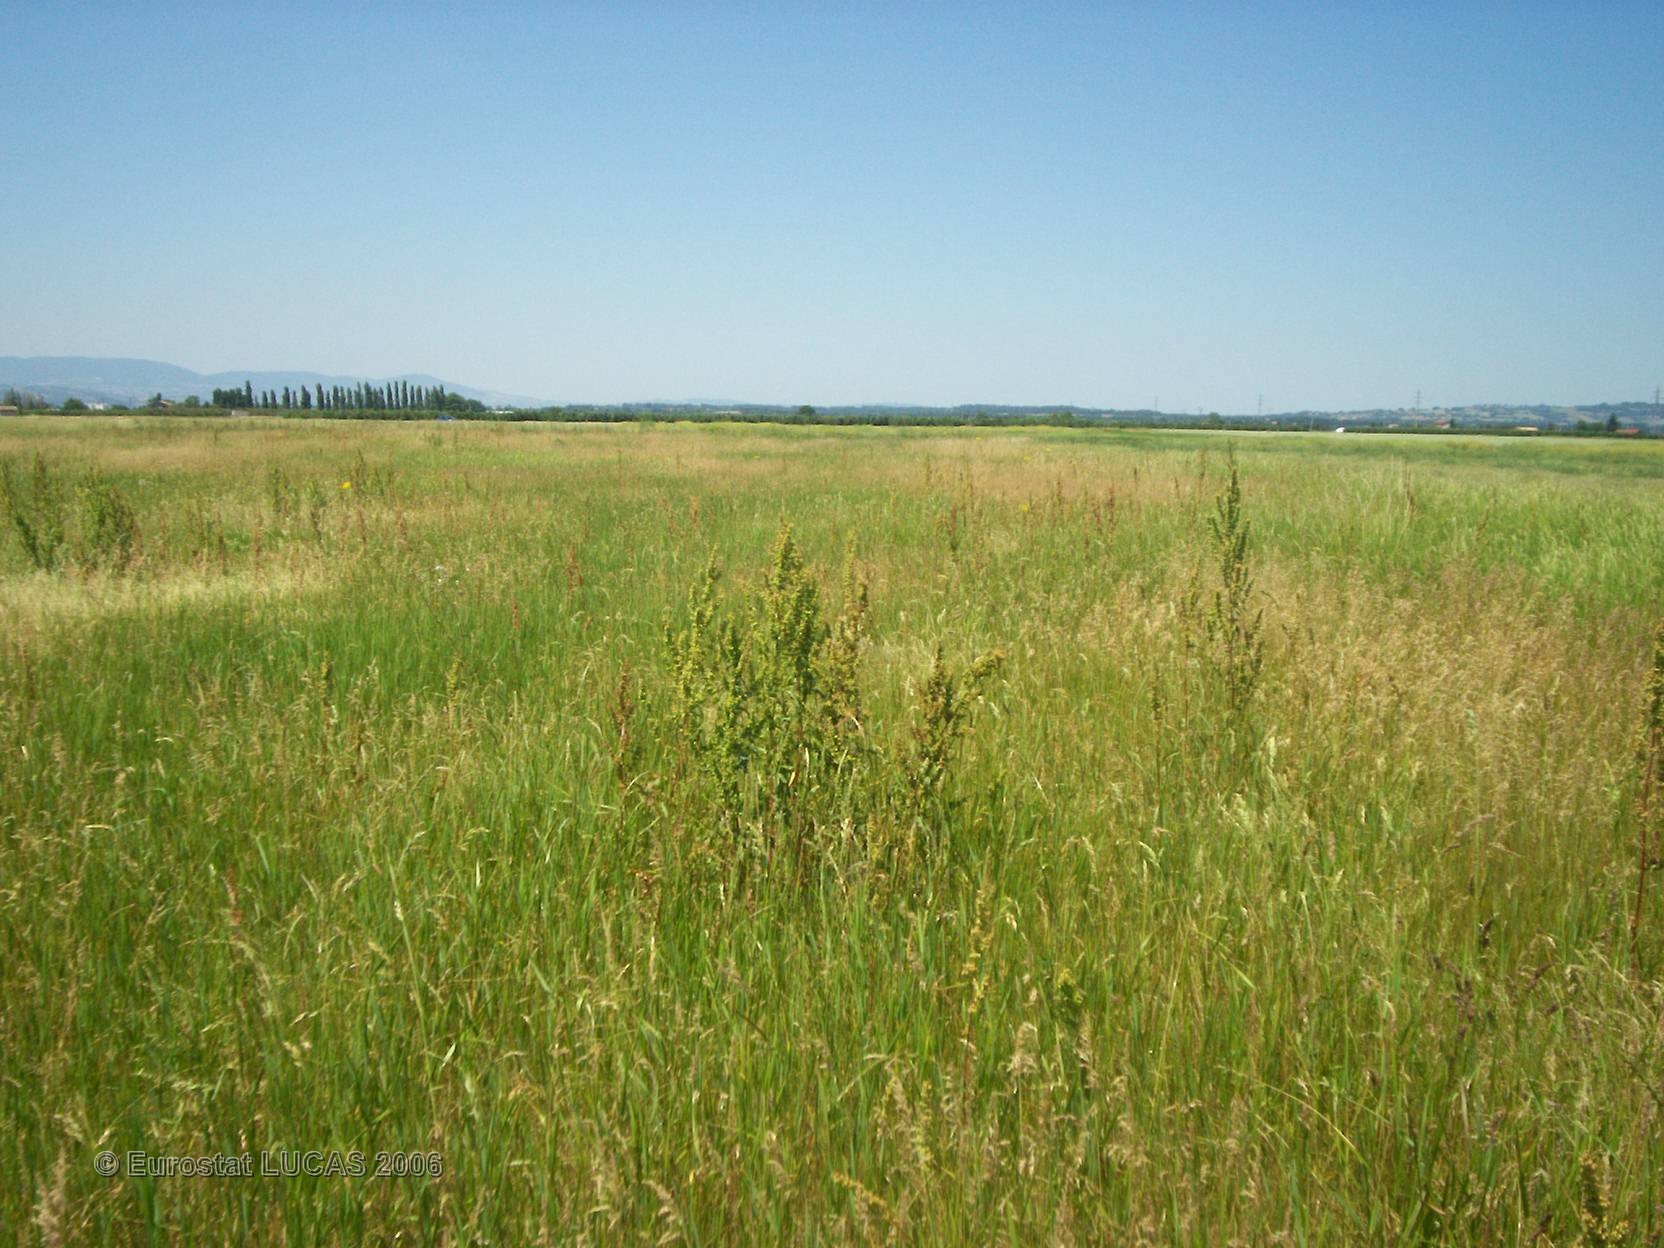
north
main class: Grassland
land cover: Grassland without tree/shrub cover
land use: Agriculture (excluding fallow land and kitchen gardens)
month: June
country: FR
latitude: 45.2700
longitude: 4.8427
